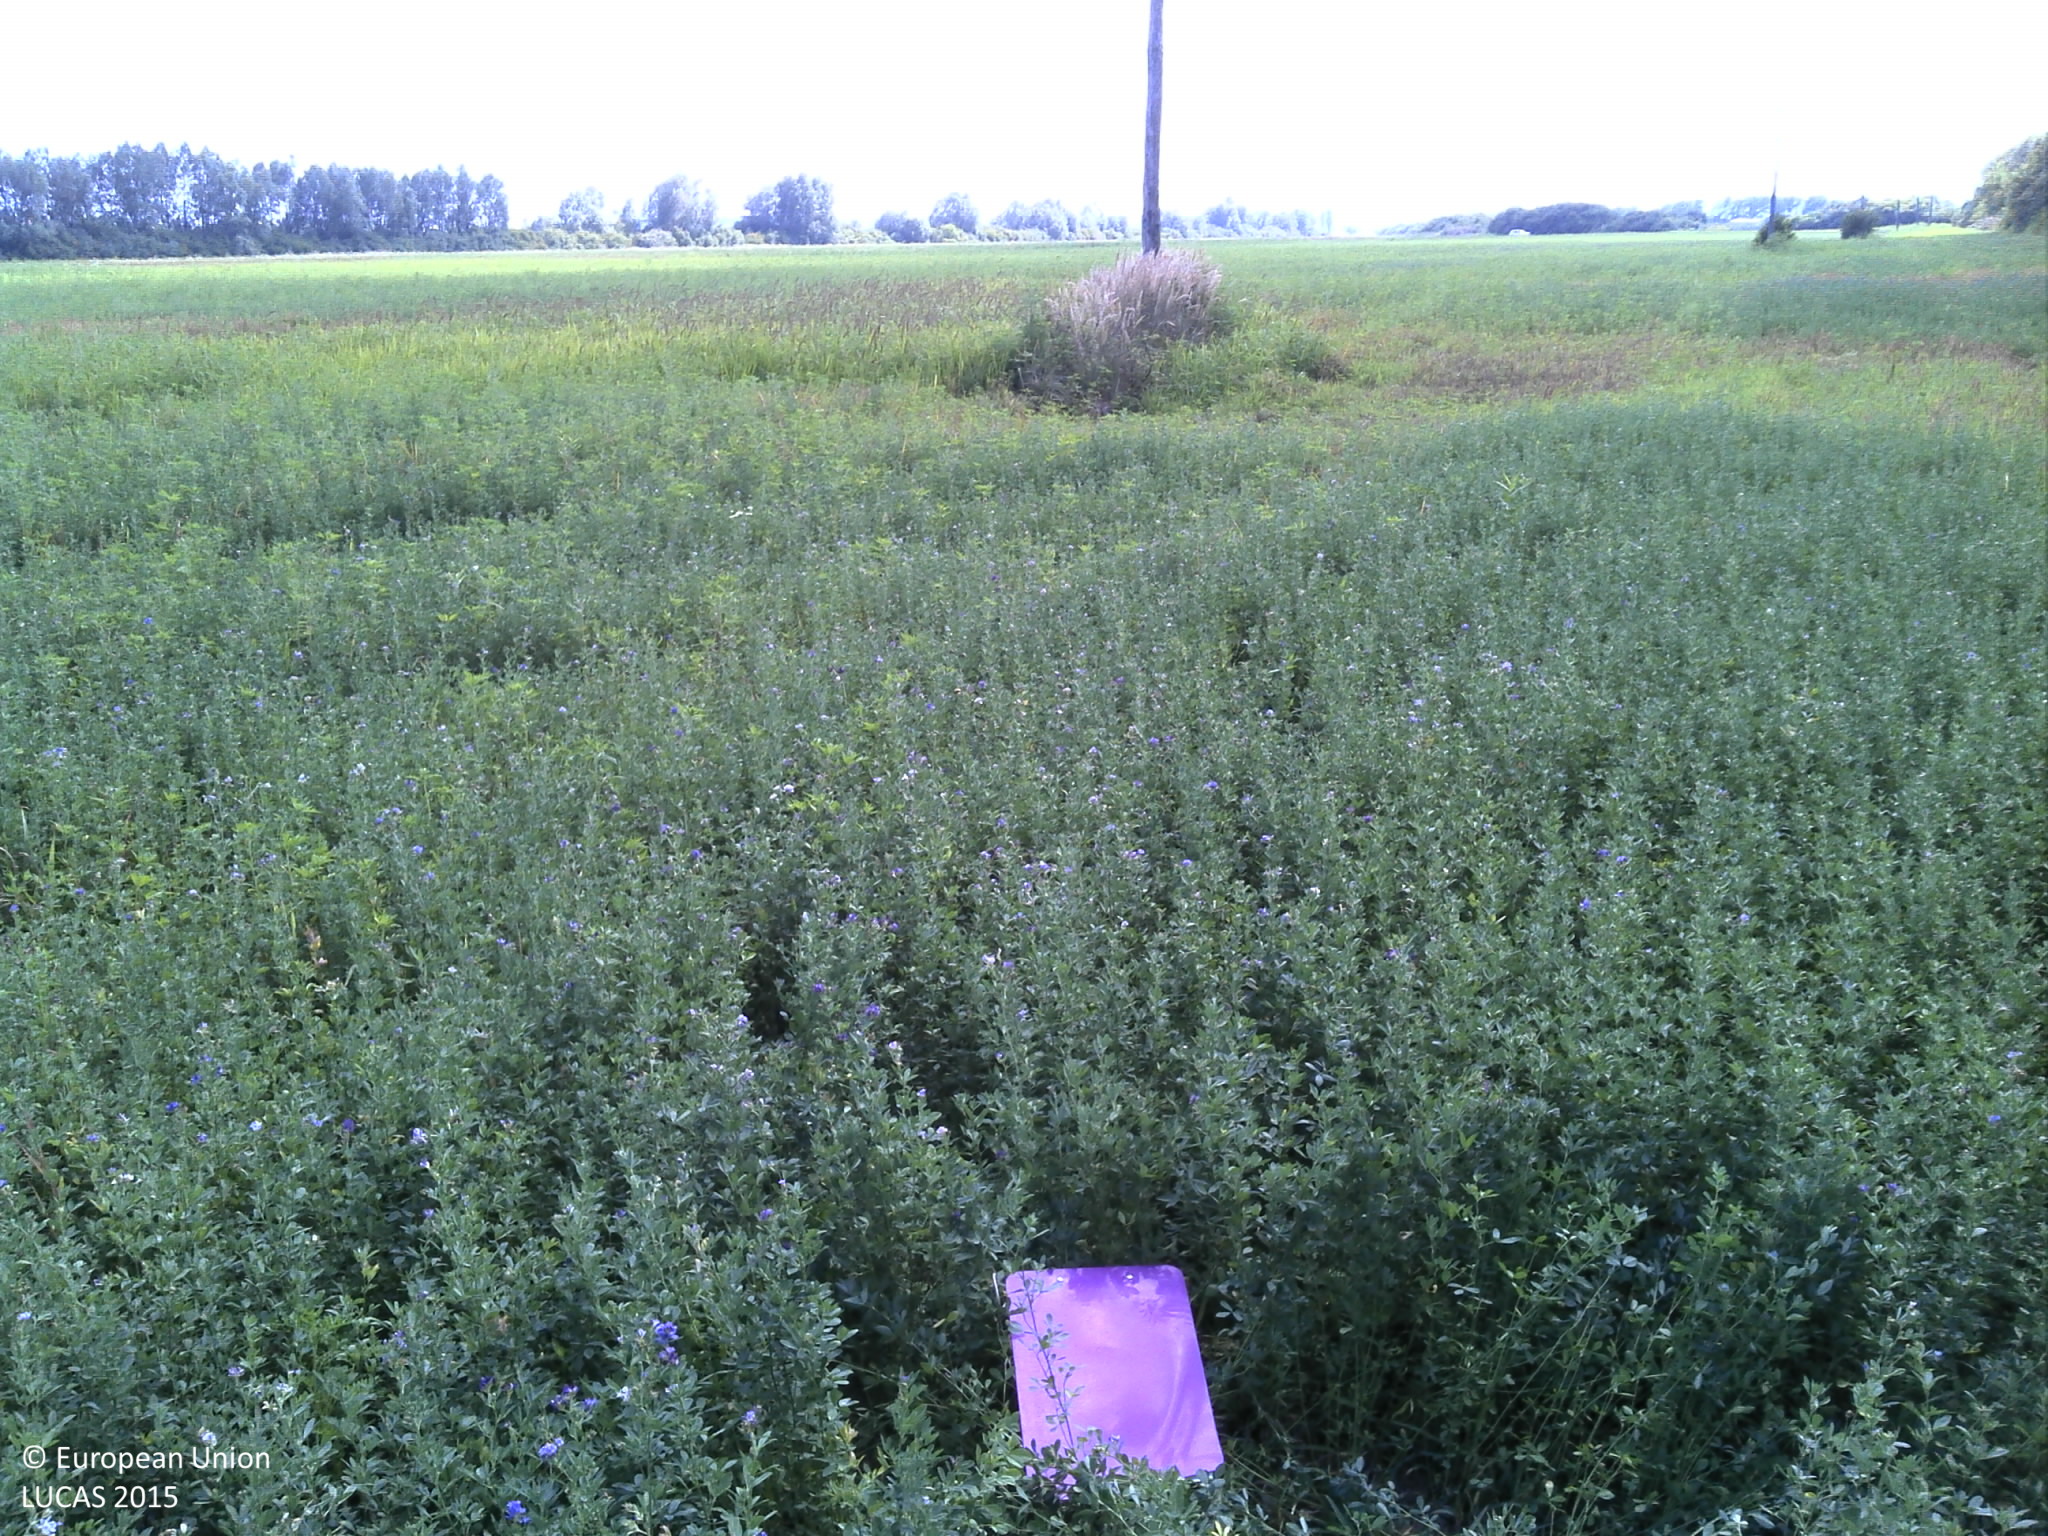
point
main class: Cropland
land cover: Clovers
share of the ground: > 75 %
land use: Agriculture (excluding fallow land and kitchen gardens)
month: August
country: HR
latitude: 45.4857
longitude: 16.4849
